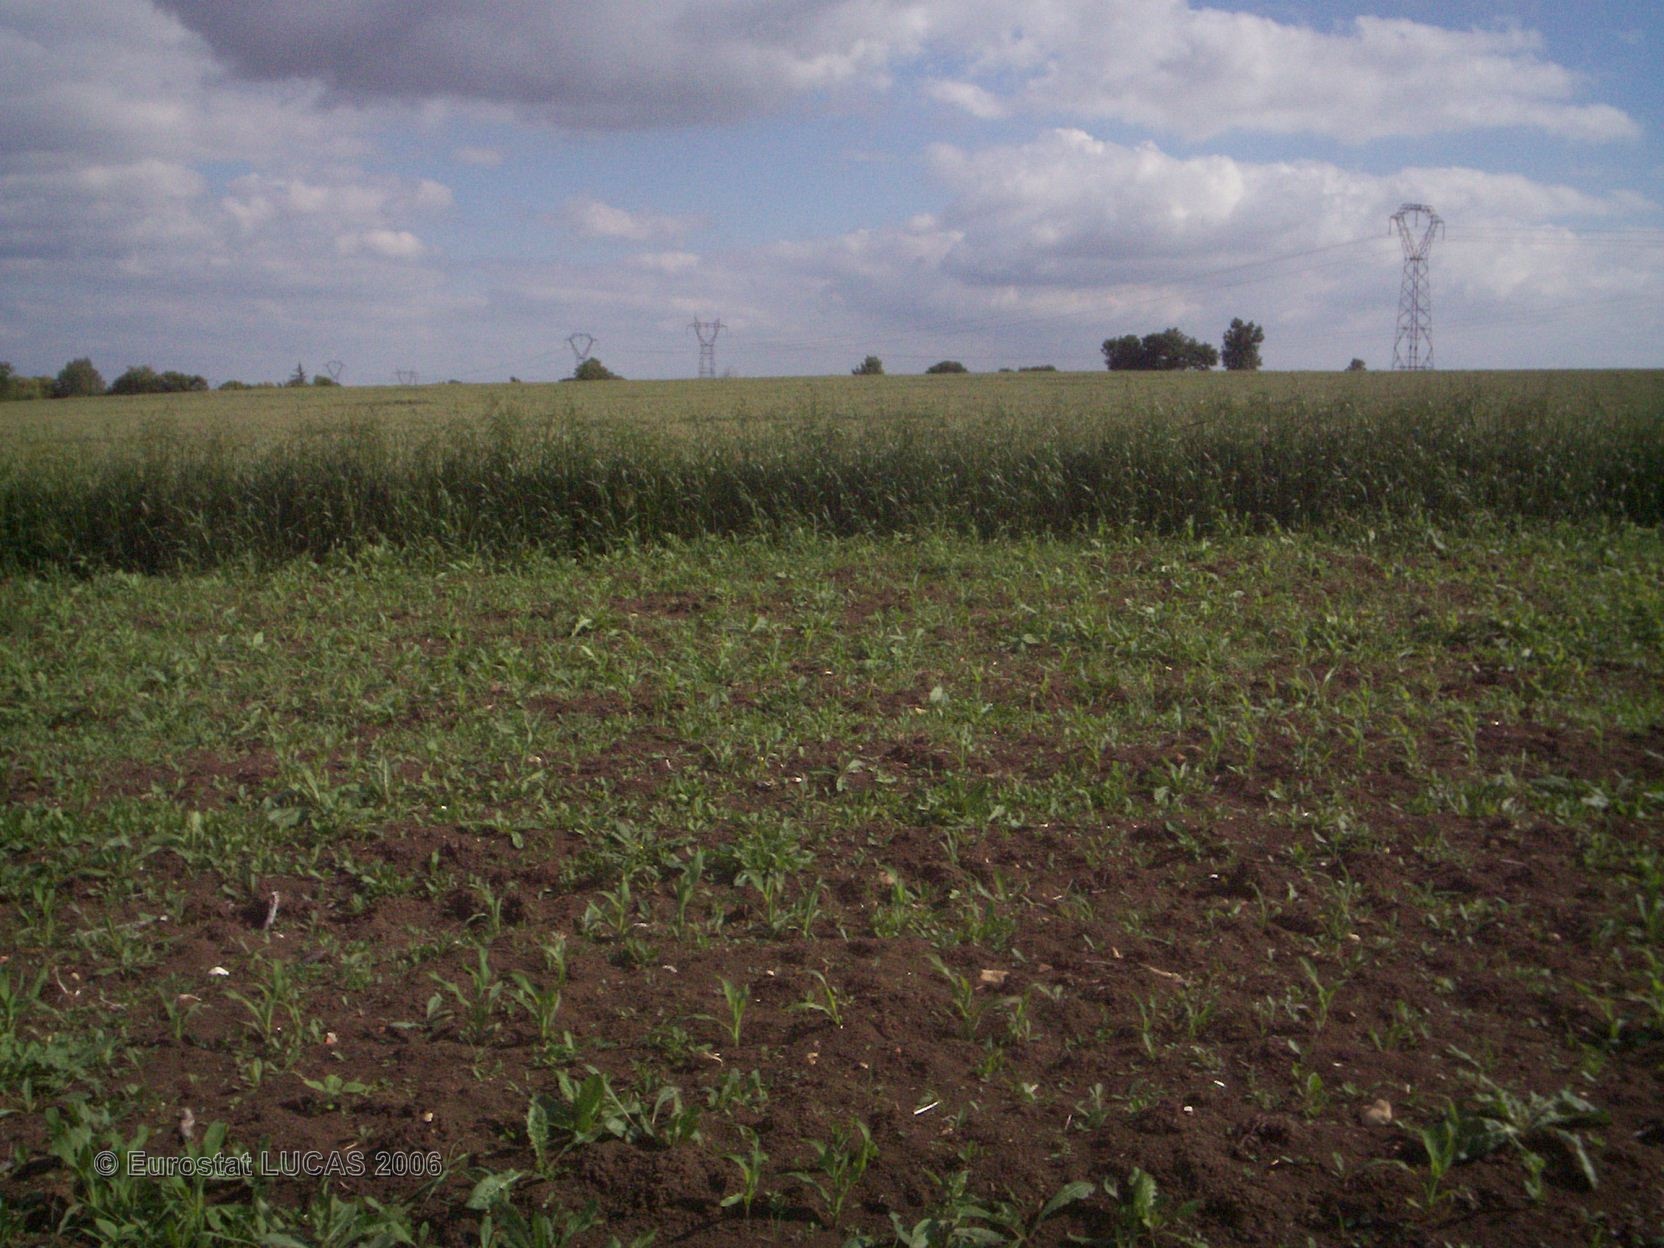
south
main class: Cropland
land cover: Maize
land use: Agriculture (excluding fallow land and kitchen gardens)
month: May
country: FR
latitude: 45.9456
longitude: -0.8243
